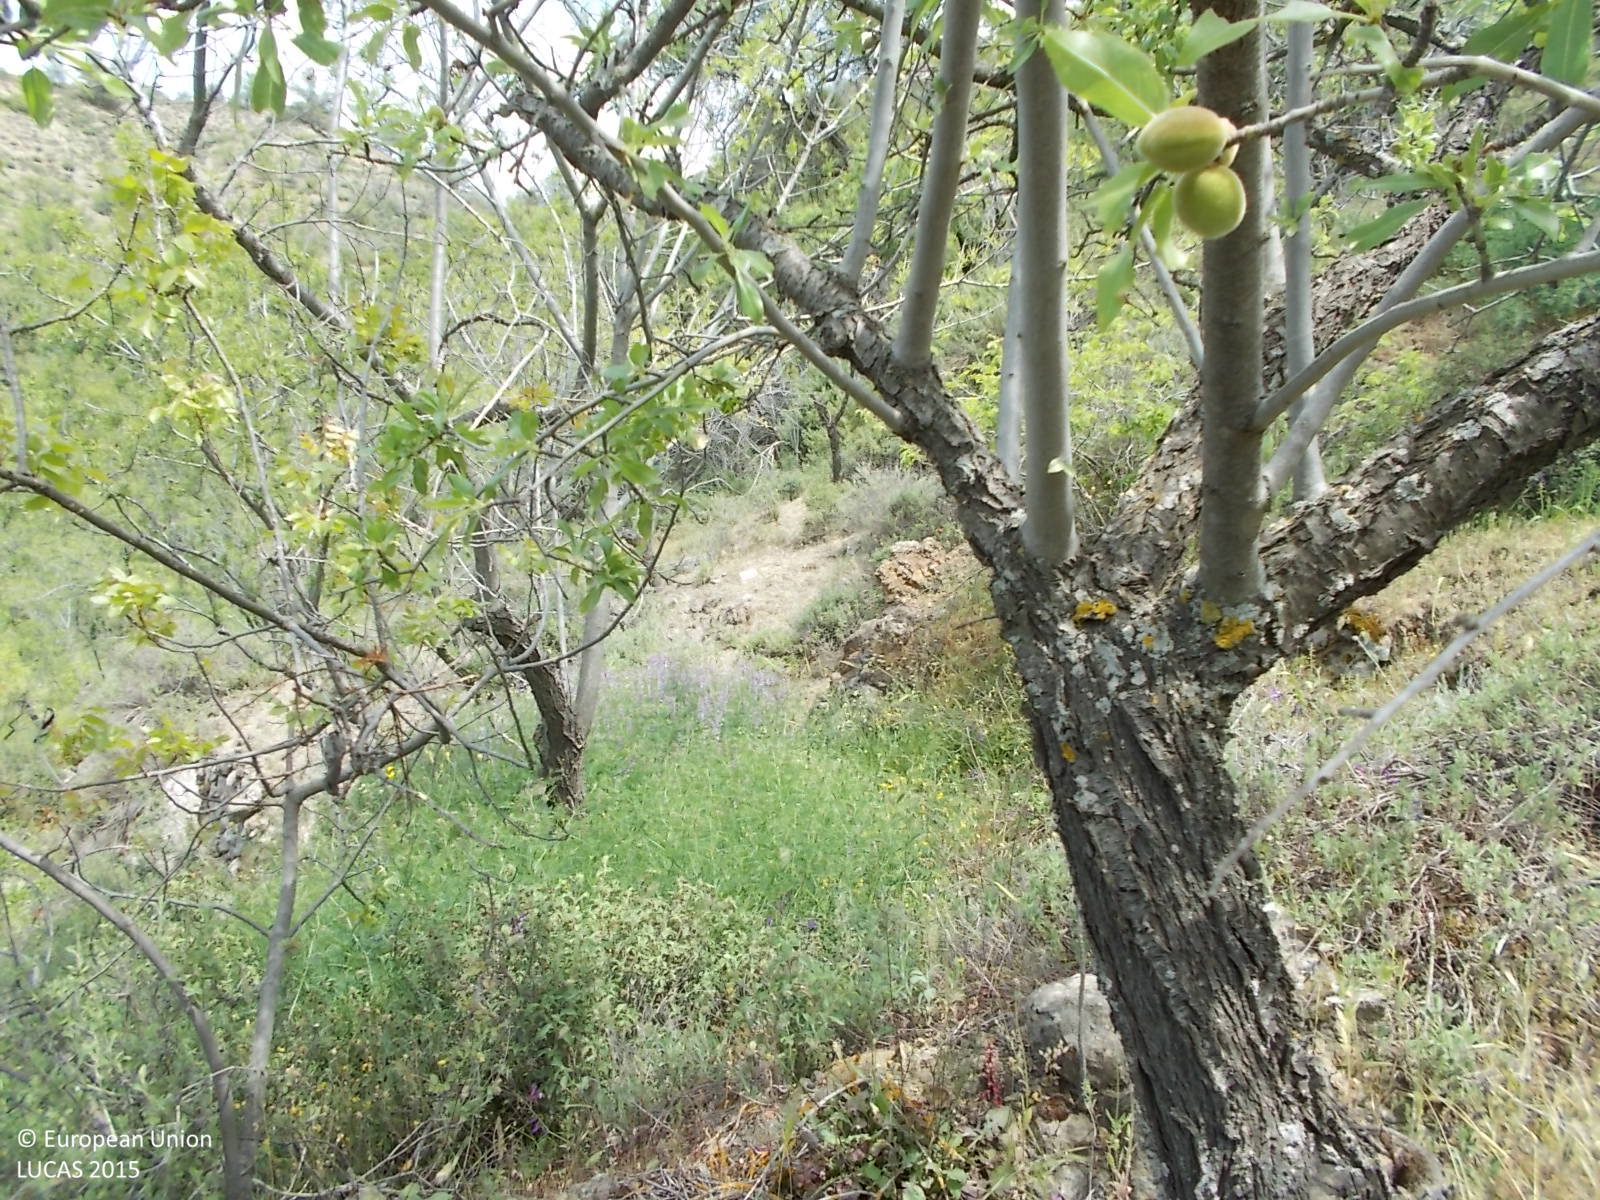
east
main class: Cropland
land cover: Nuts trees
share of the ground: > 75 %
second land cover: Grassland without tree/shrub cover
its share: > 75 %
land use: Abandoned areas
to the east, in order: Nuts trees; Grassland without tree/shrub cover; Vineyards; Nuts trees; Shrubland with sparse tree cover; Nuts trees; Shrubland with sparse tree cover
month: May
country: CY
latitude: 34.9449
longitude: 33.0700
